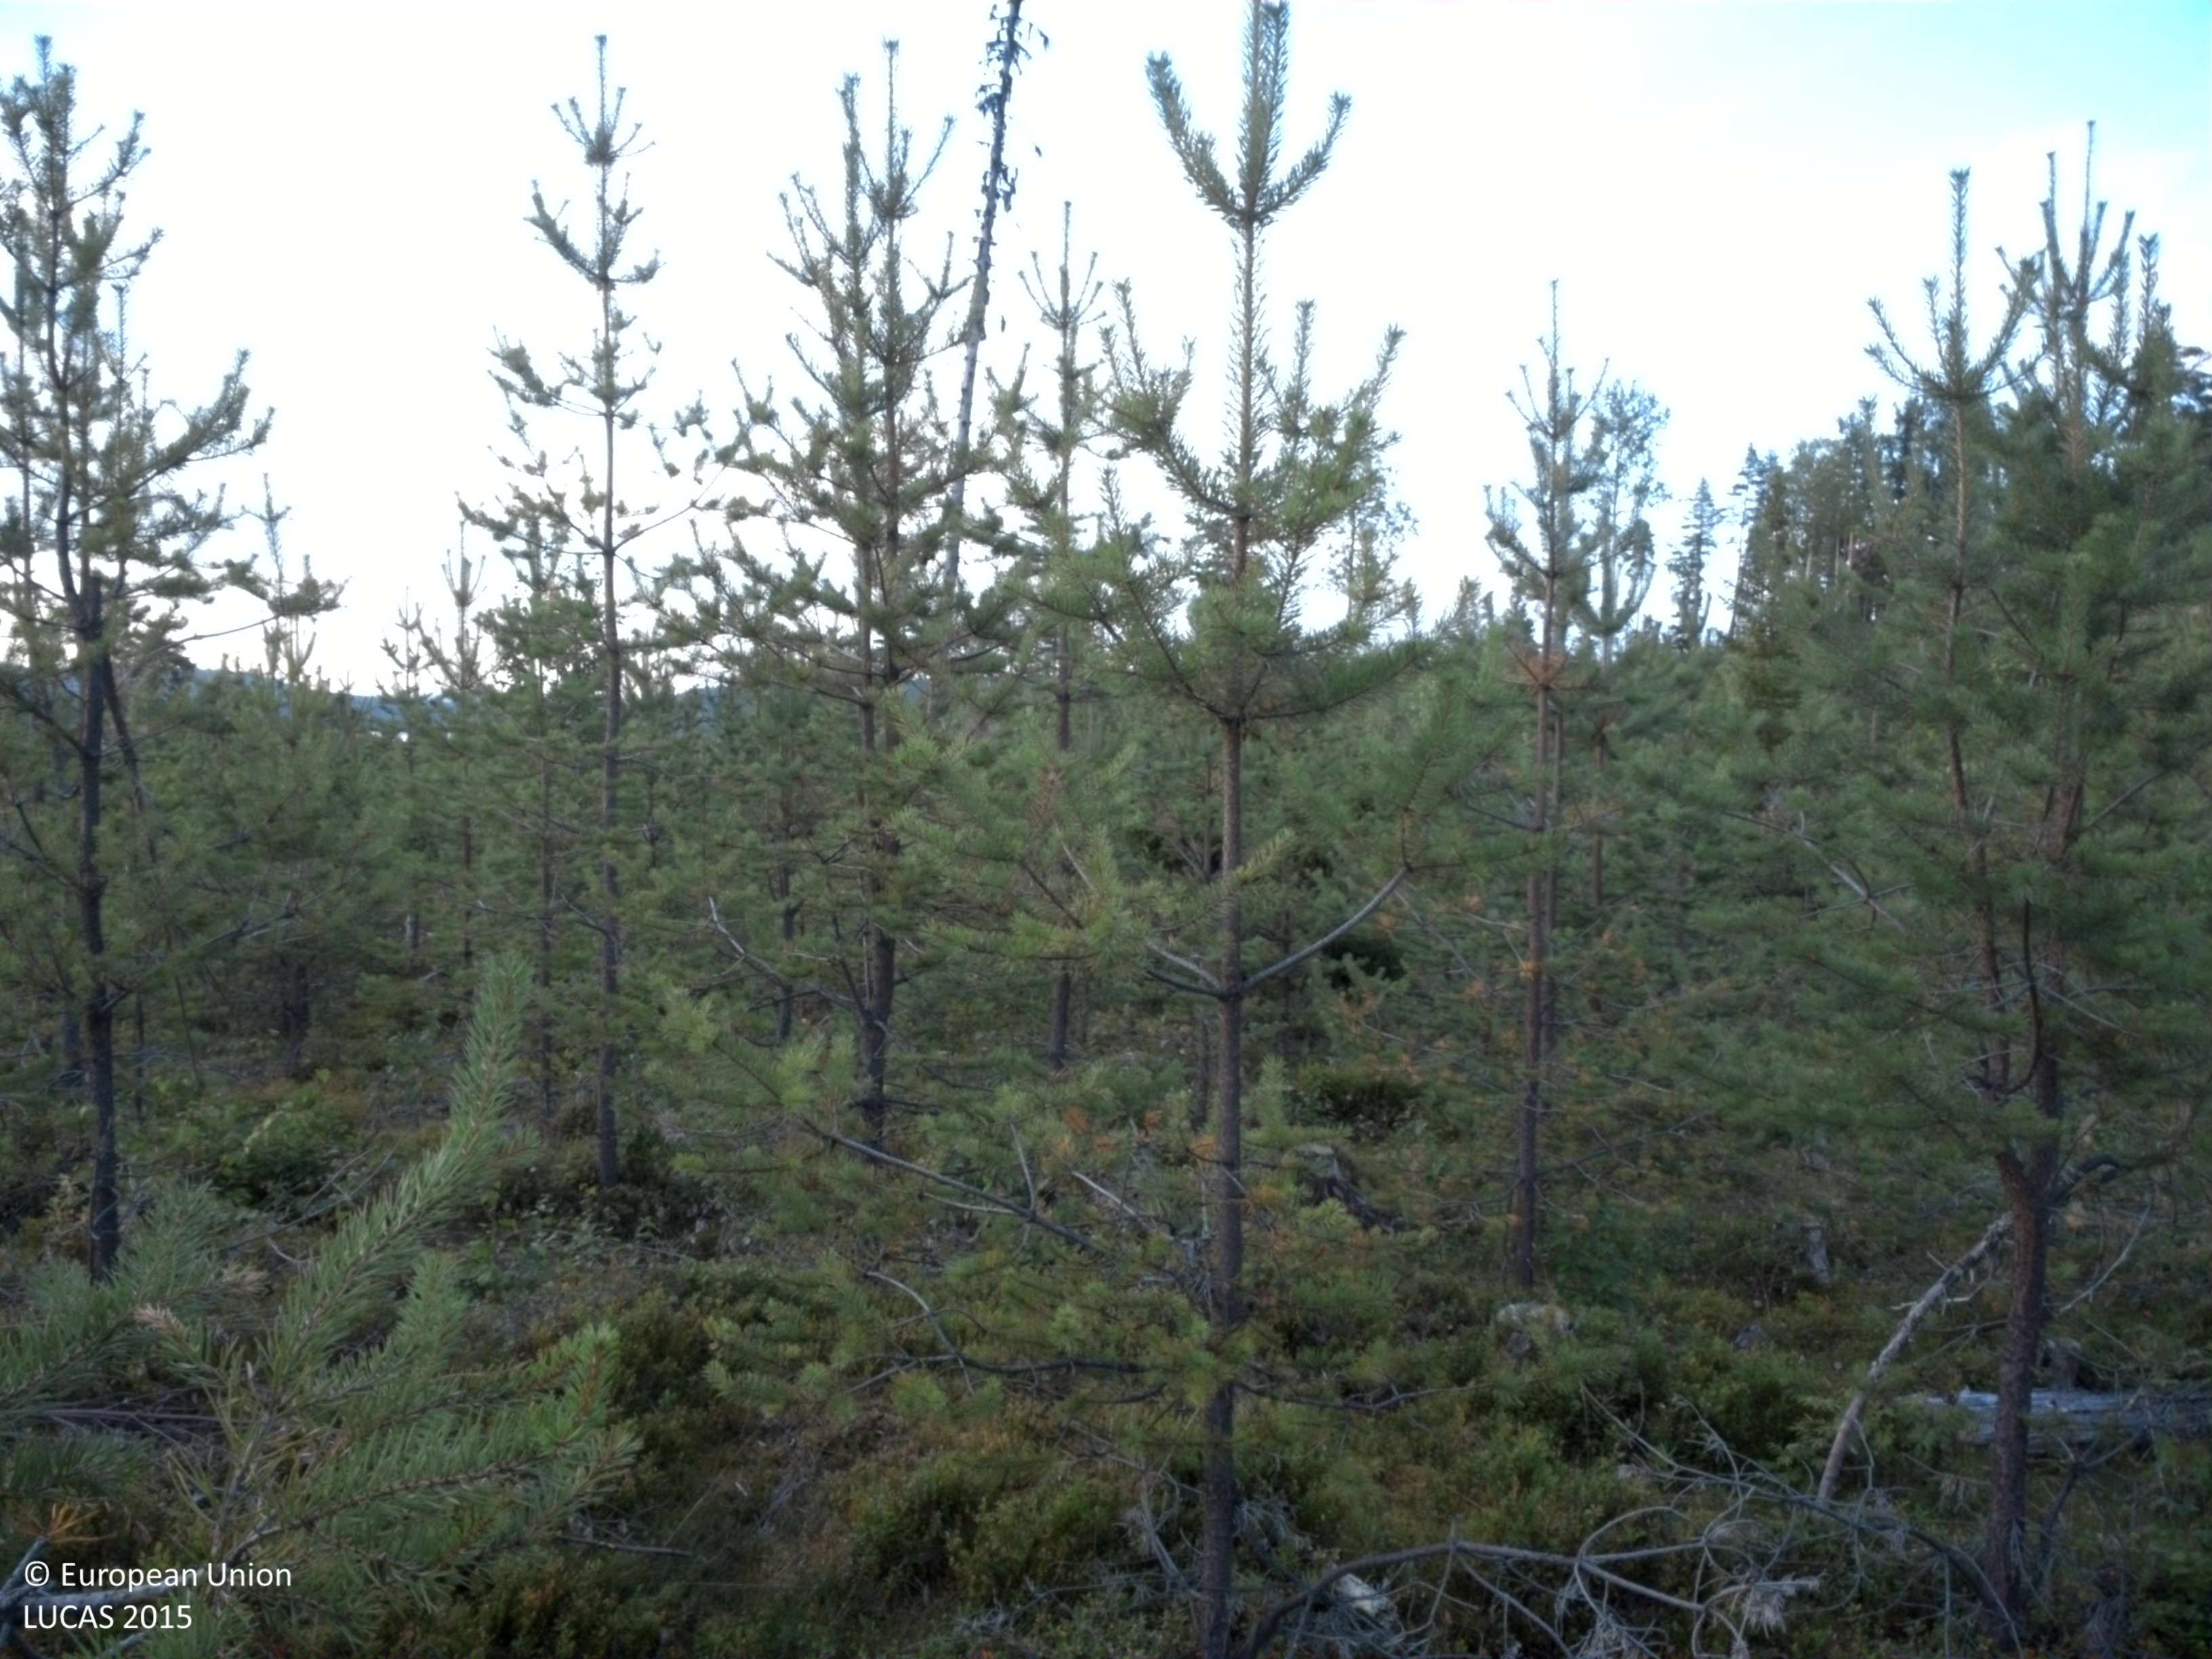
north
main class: Woodland
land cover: Pine dominated coniferous woodland
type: boreal forest
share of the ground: 25 - 50 %
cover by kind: coniferous forest trees 50 %, shrubs 40 %, lichens and mosses 10 %
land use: Forestry
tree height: < 5 m
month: August
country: SE
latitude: 64.3888
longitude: 18.8236
